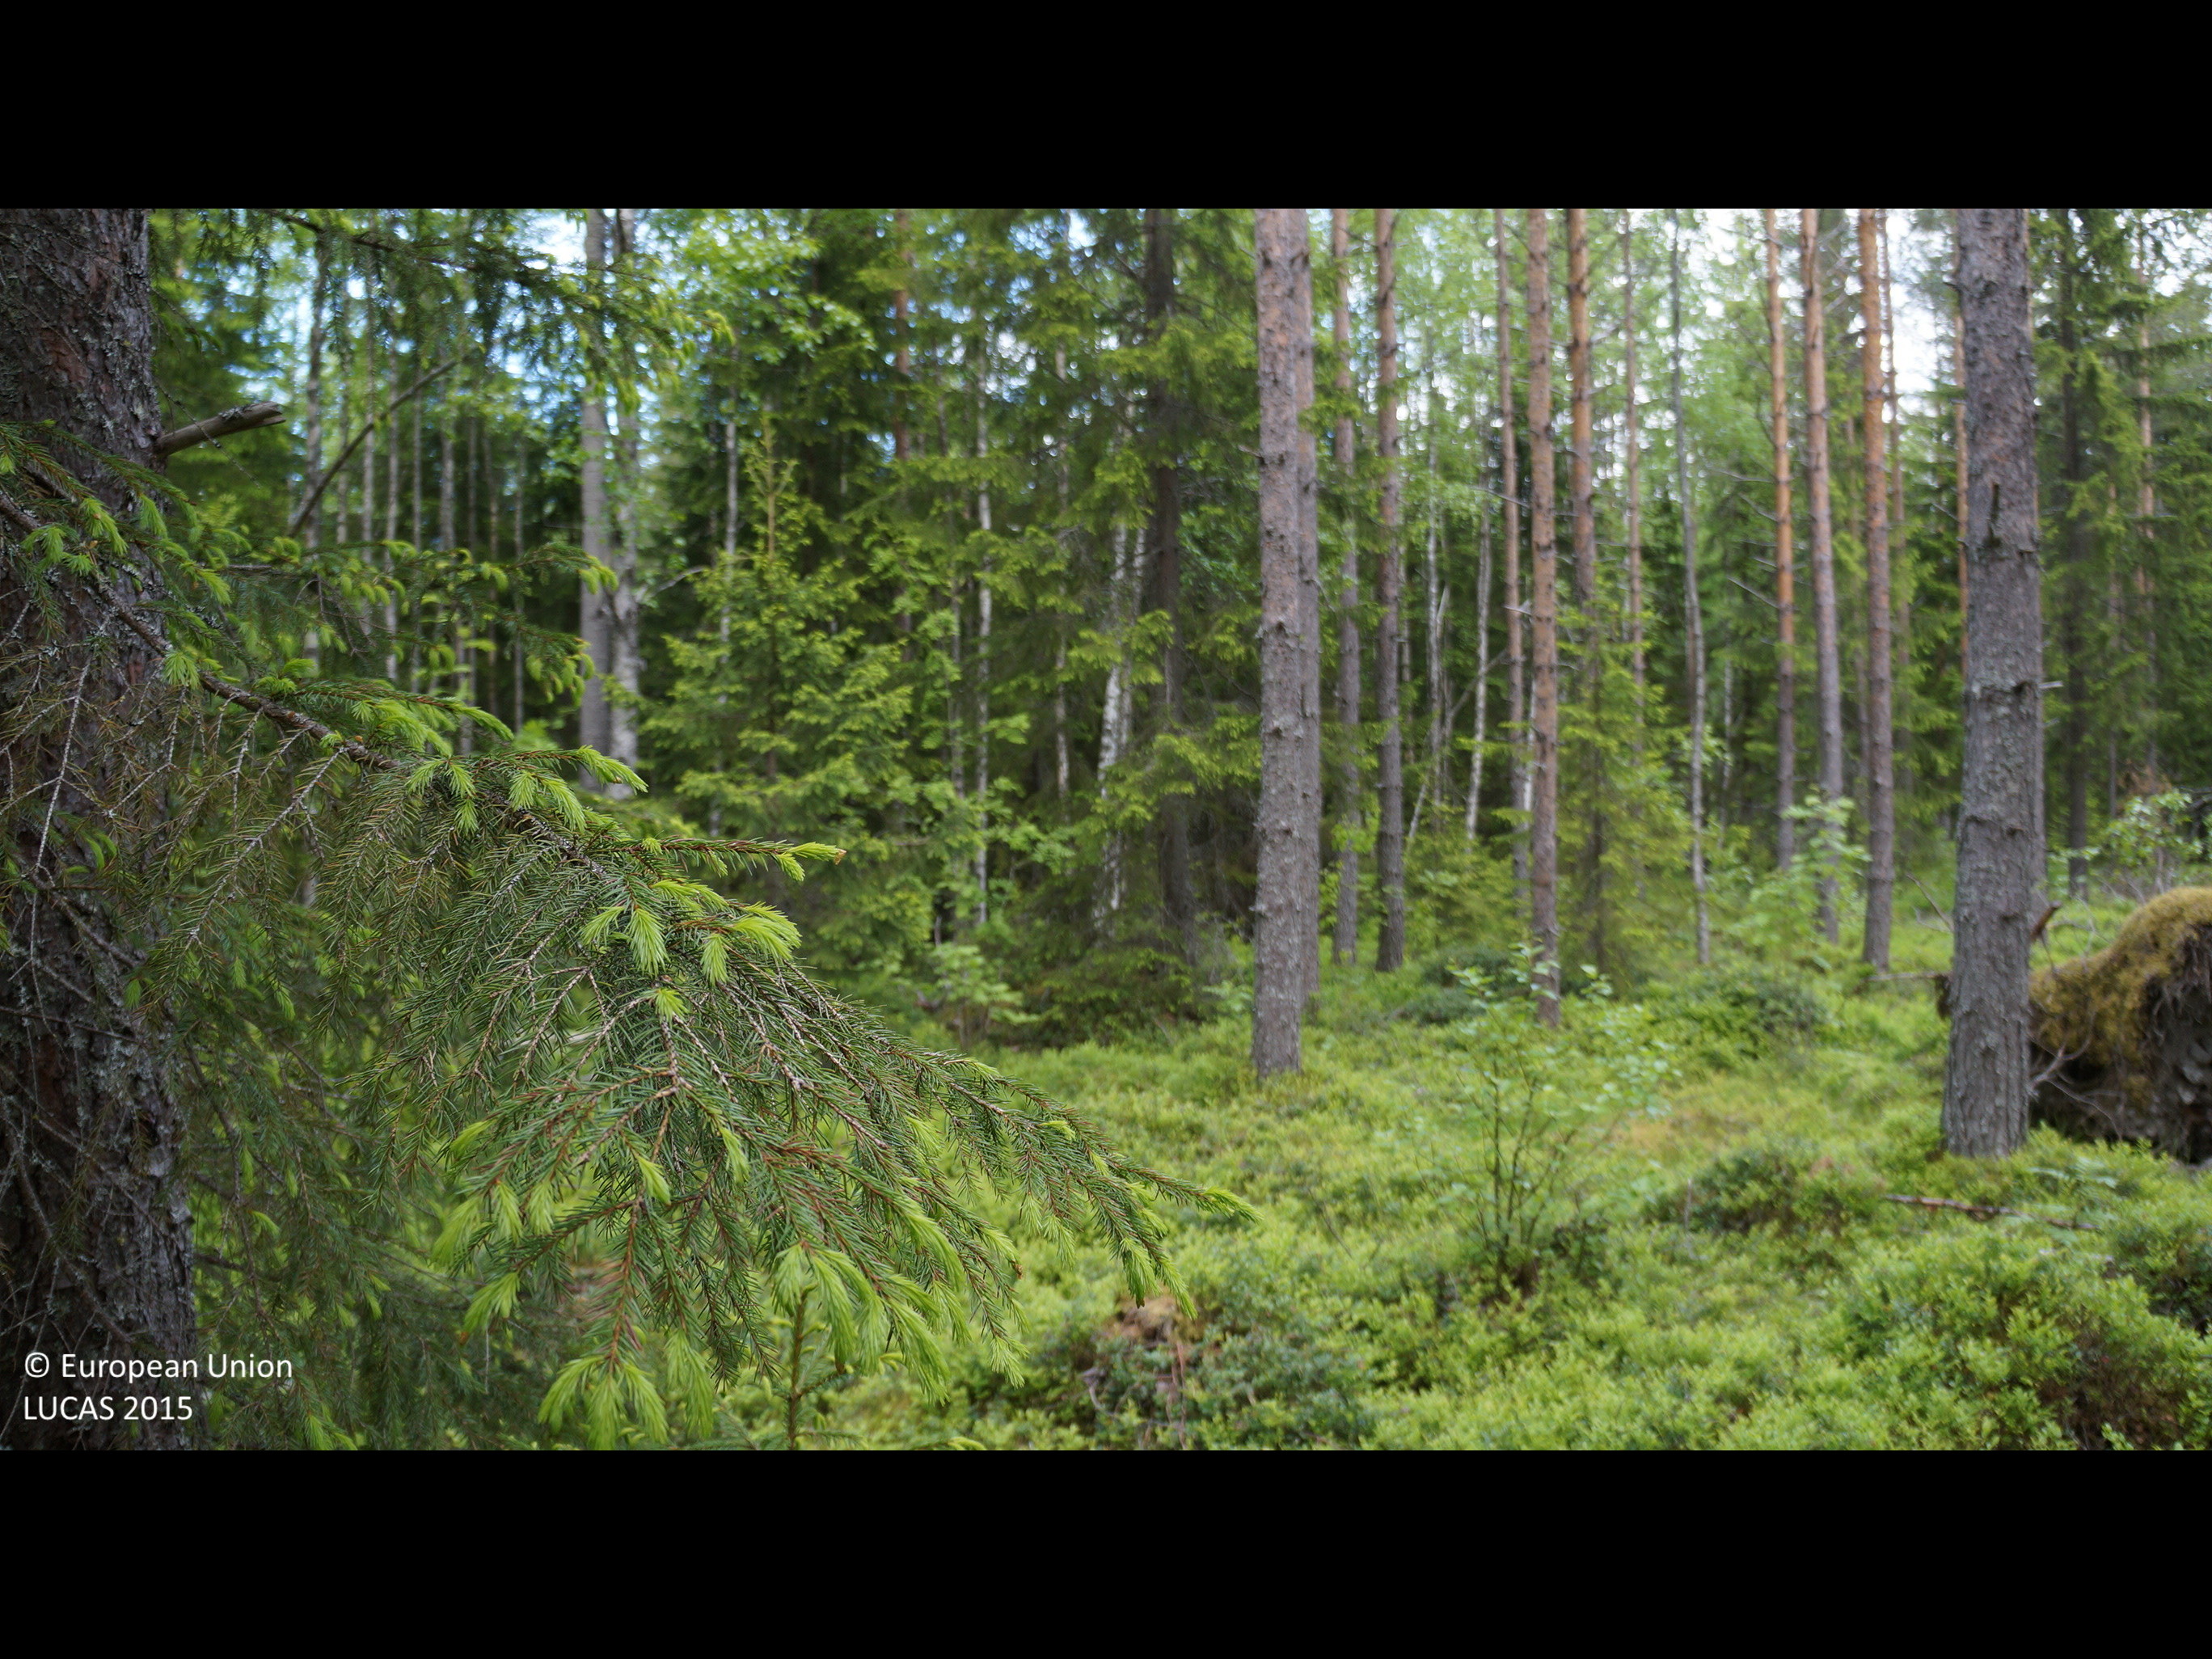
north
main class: Woodland
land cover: Pine dominated coniferous woodland
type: boreal forest
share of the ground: > 75 %
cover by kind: coniferous forest trees 70 %, shrubs 15 %, lichens and mosses 15 %
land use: Forestry
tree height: > 5 m
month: June
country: FI
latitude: 64.1720
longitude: 25.2500
